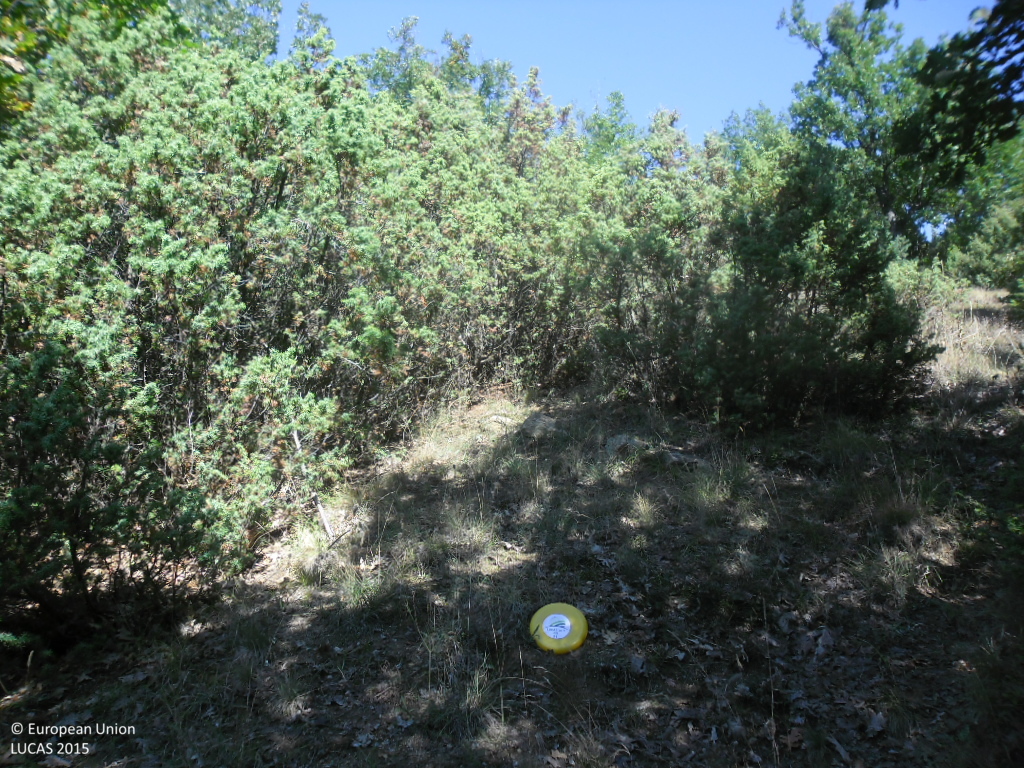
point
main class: Woodland
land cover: Other mixed woodland
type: hemiboreal forest and nemoral coniferous forest and mixed broadleaved-coniferous forest
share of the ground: > 75 %
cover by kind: coniferous forest trees 60 %, broadleaved forest trees 40 %
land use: Forestry
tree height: < 5 m
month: September
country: BG
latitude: 42.0055
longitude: 23.1980
